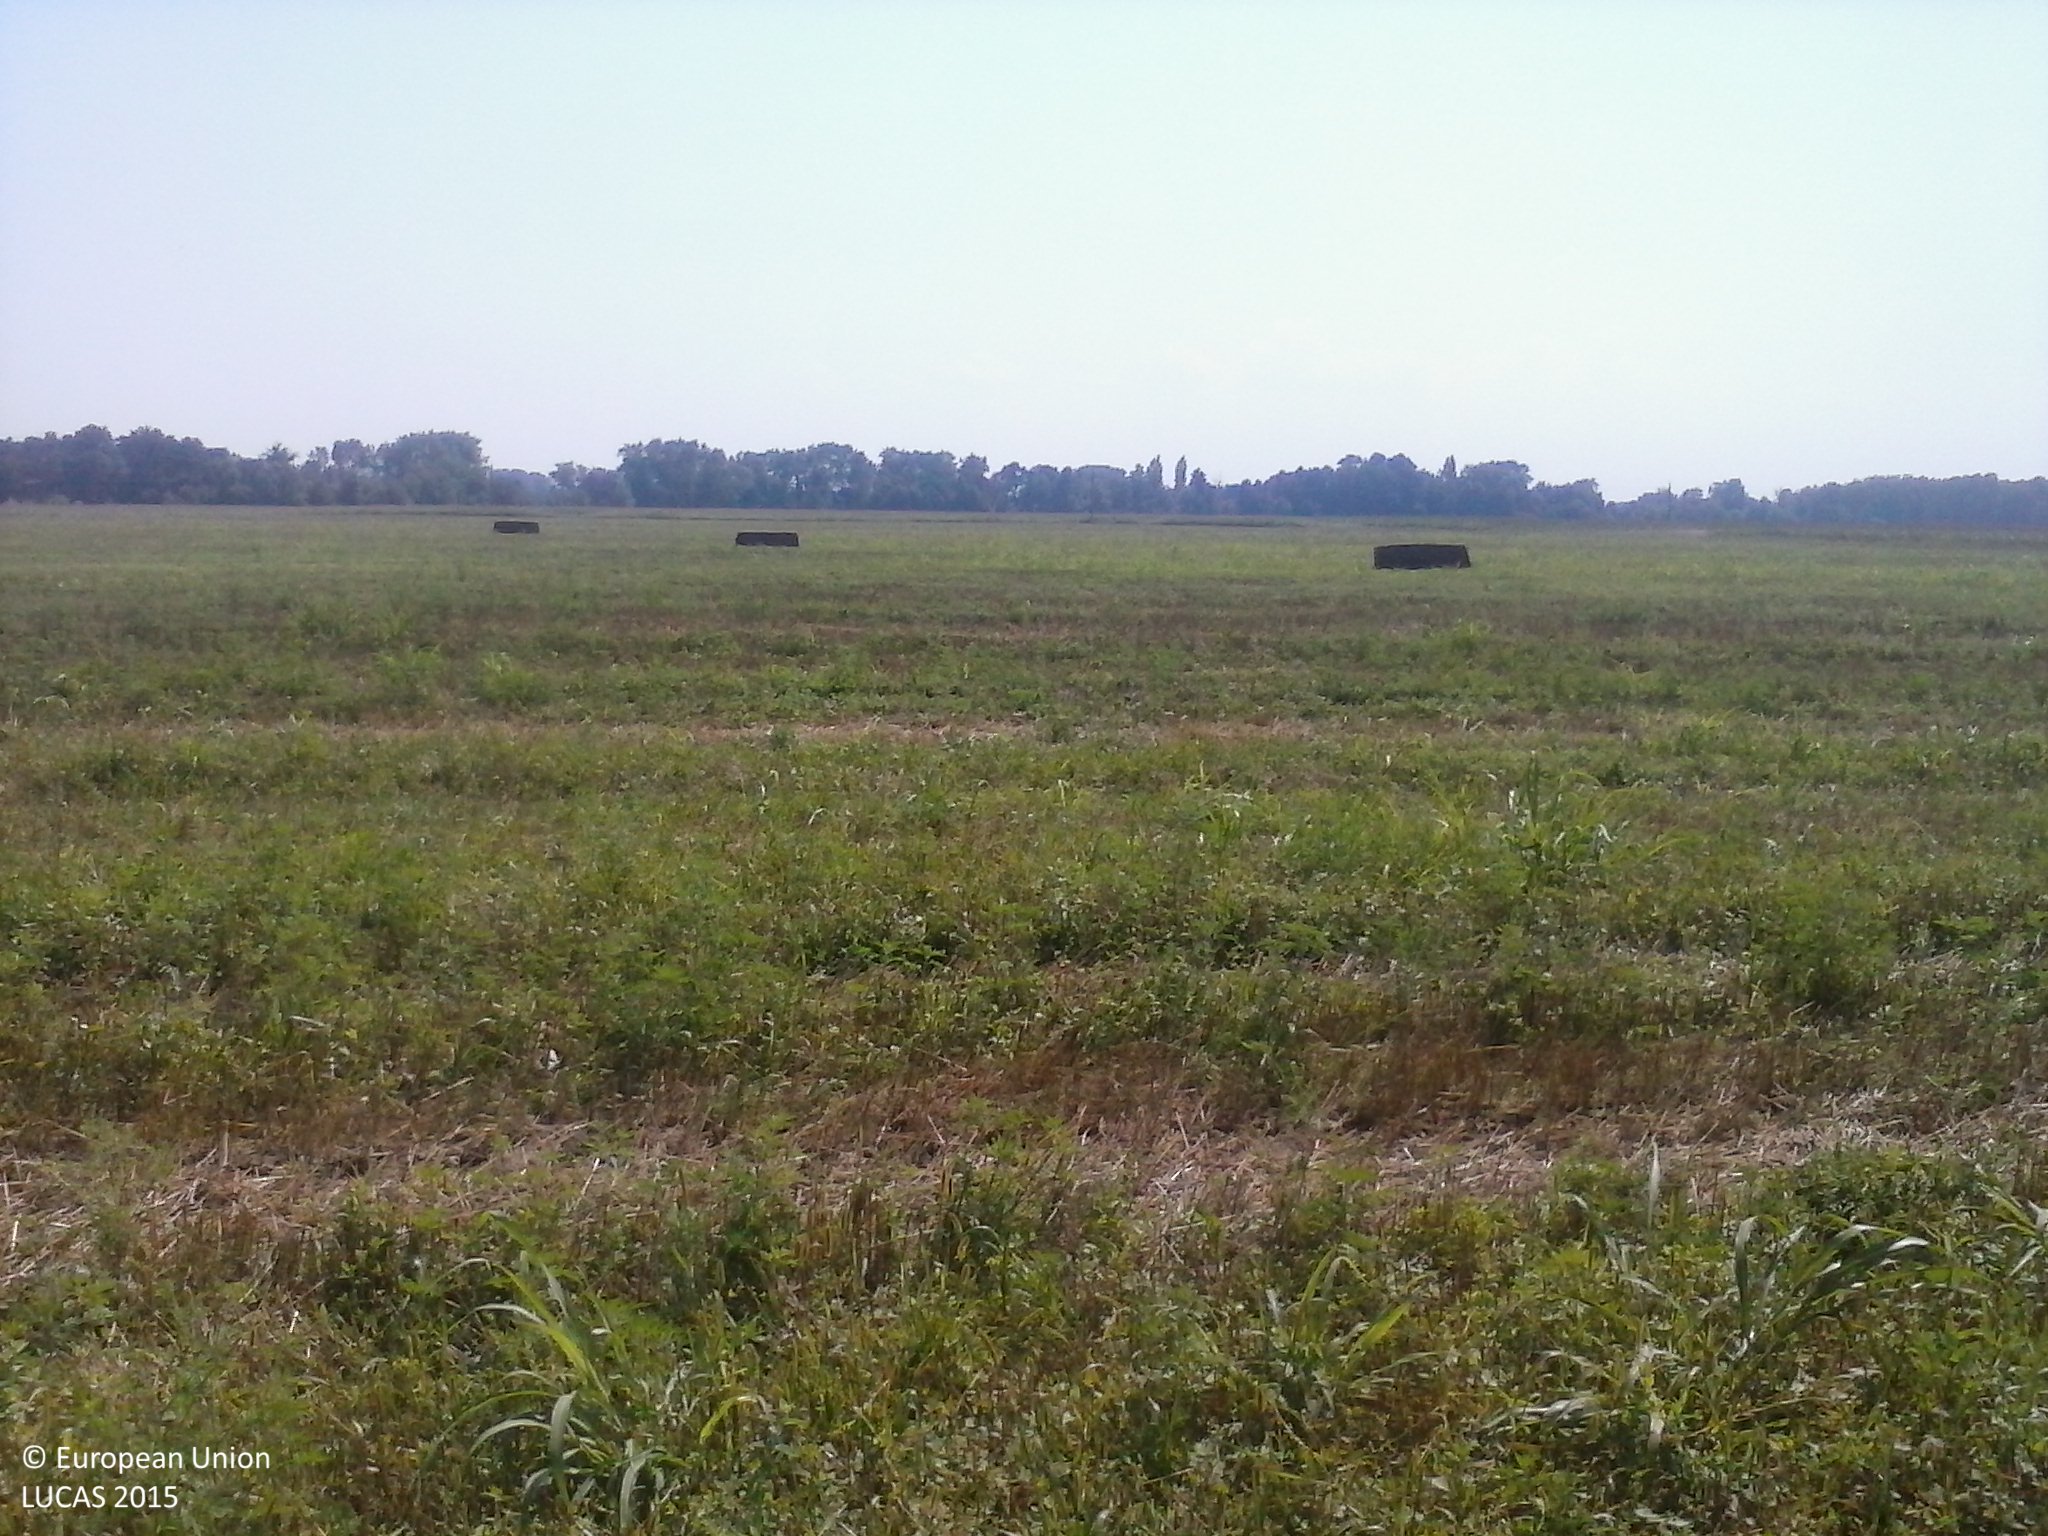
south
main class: Cropland
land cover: Common wheat
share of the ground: 10 - 25 %
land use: Agriculture (excluding fallow land and kitchen gardens)
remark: Harvested field
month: August
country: HU
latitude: 45.8239
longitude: 17.8948
